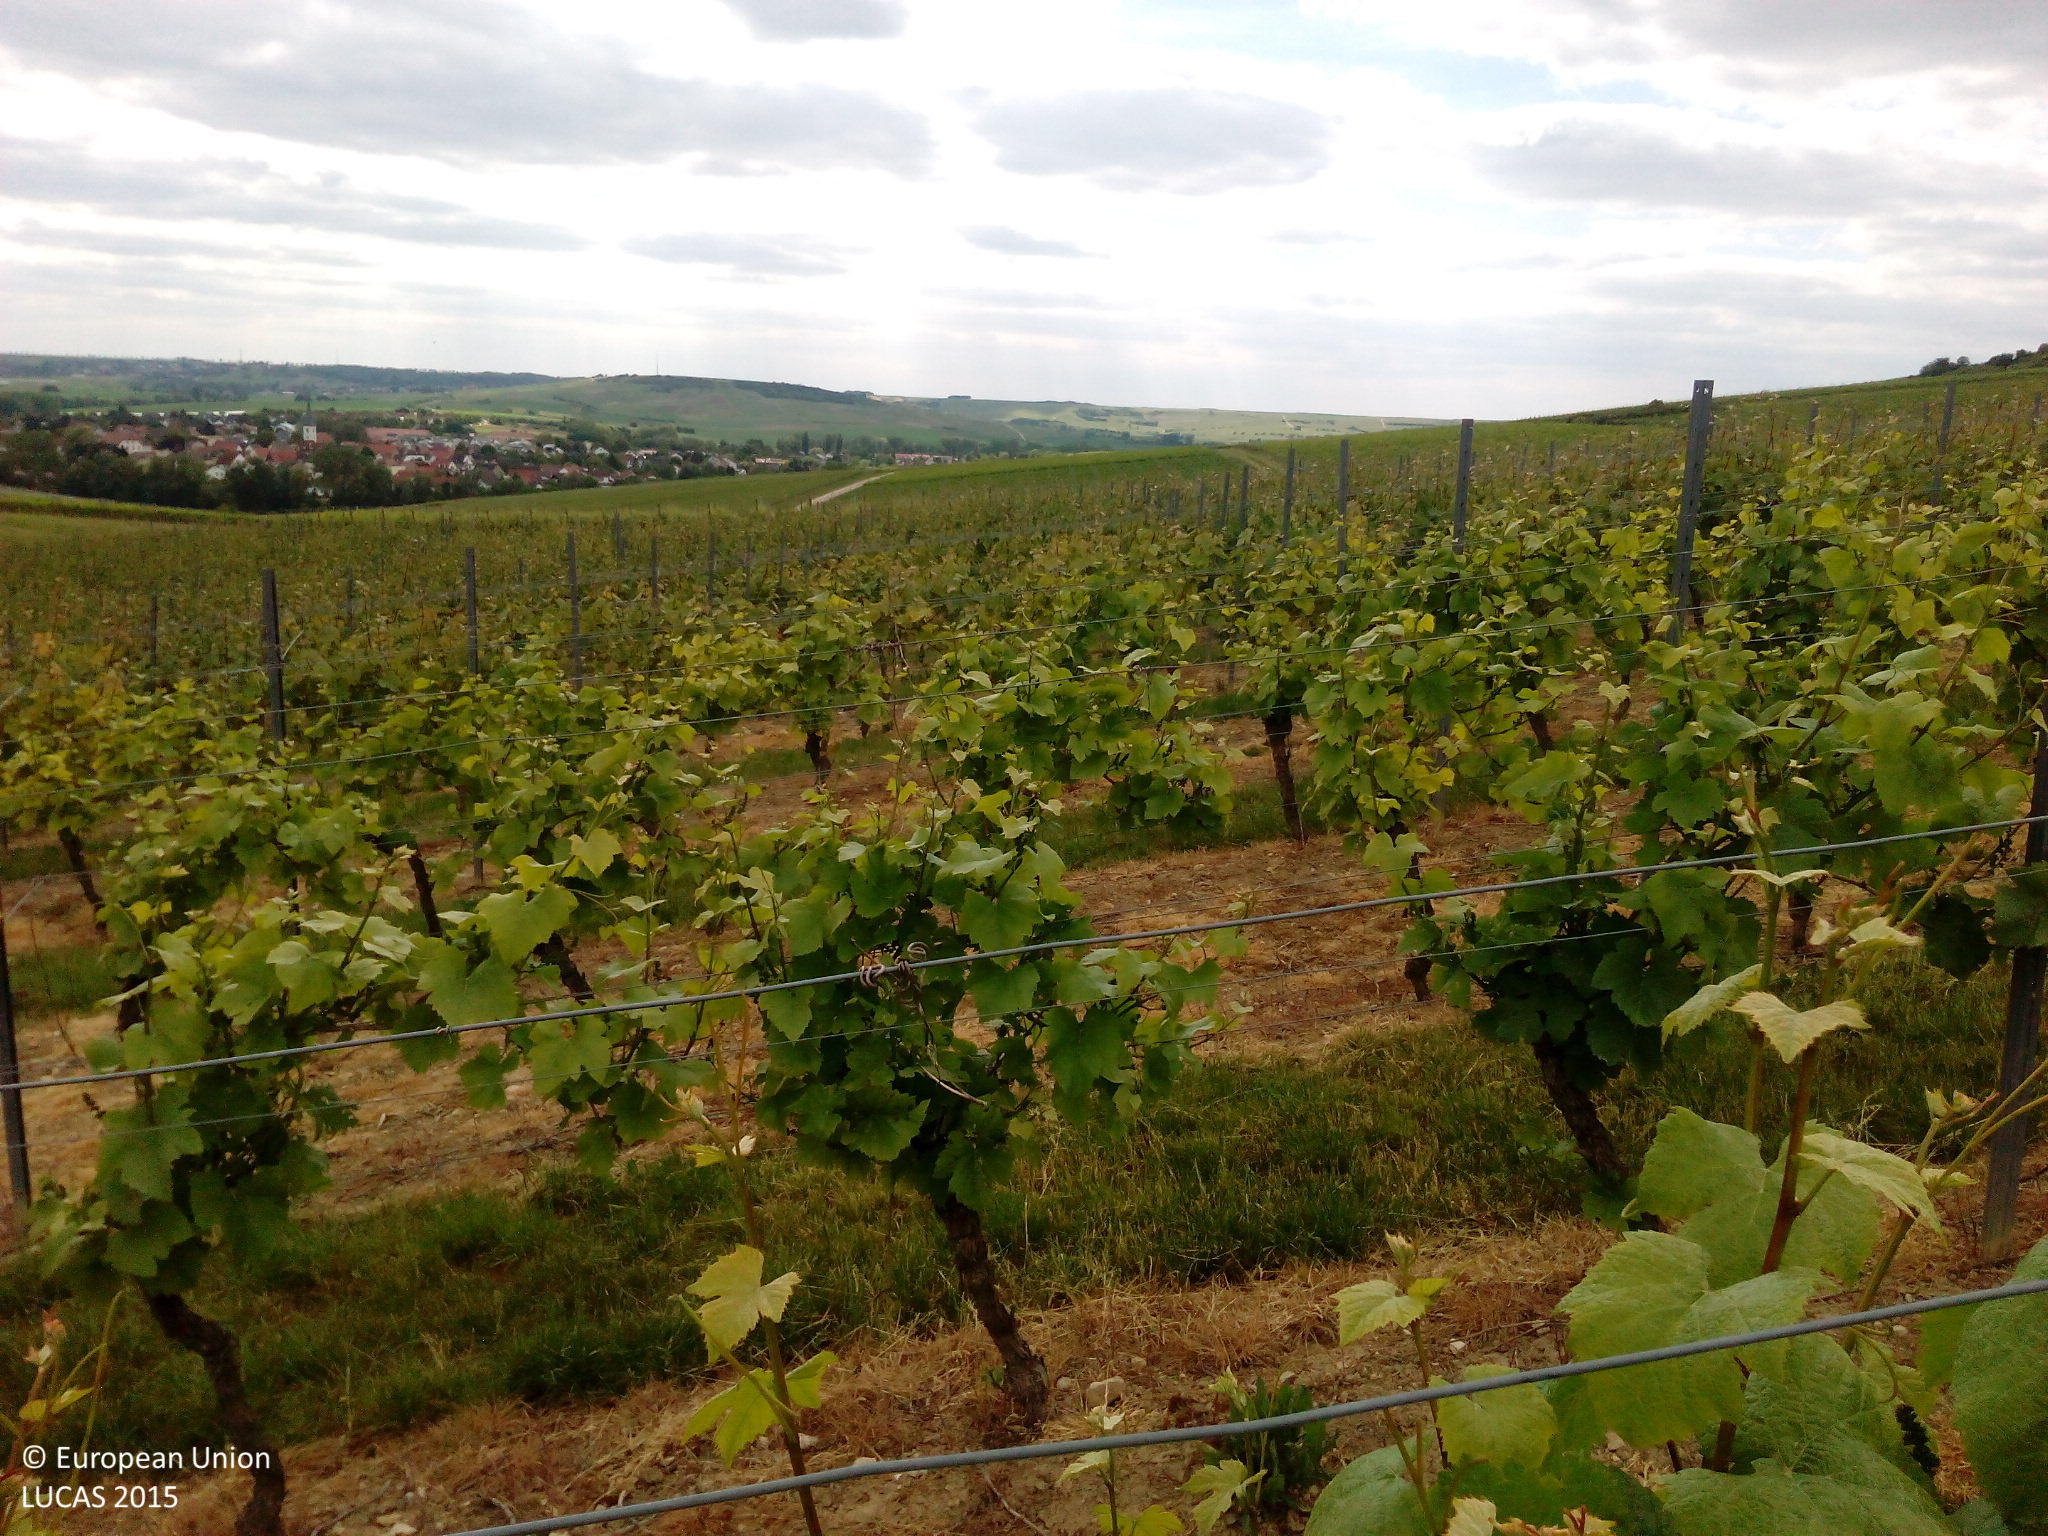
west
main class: Cropland
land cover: Vineyards
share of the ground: 50 - 75 %
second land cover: Grassland without tree/shrub cover
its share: 50 - 75 %
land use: Agriculture (excluding fallow land and kitchen gardens)
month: May
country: DE
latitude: 49.9174
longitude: 8.1481
